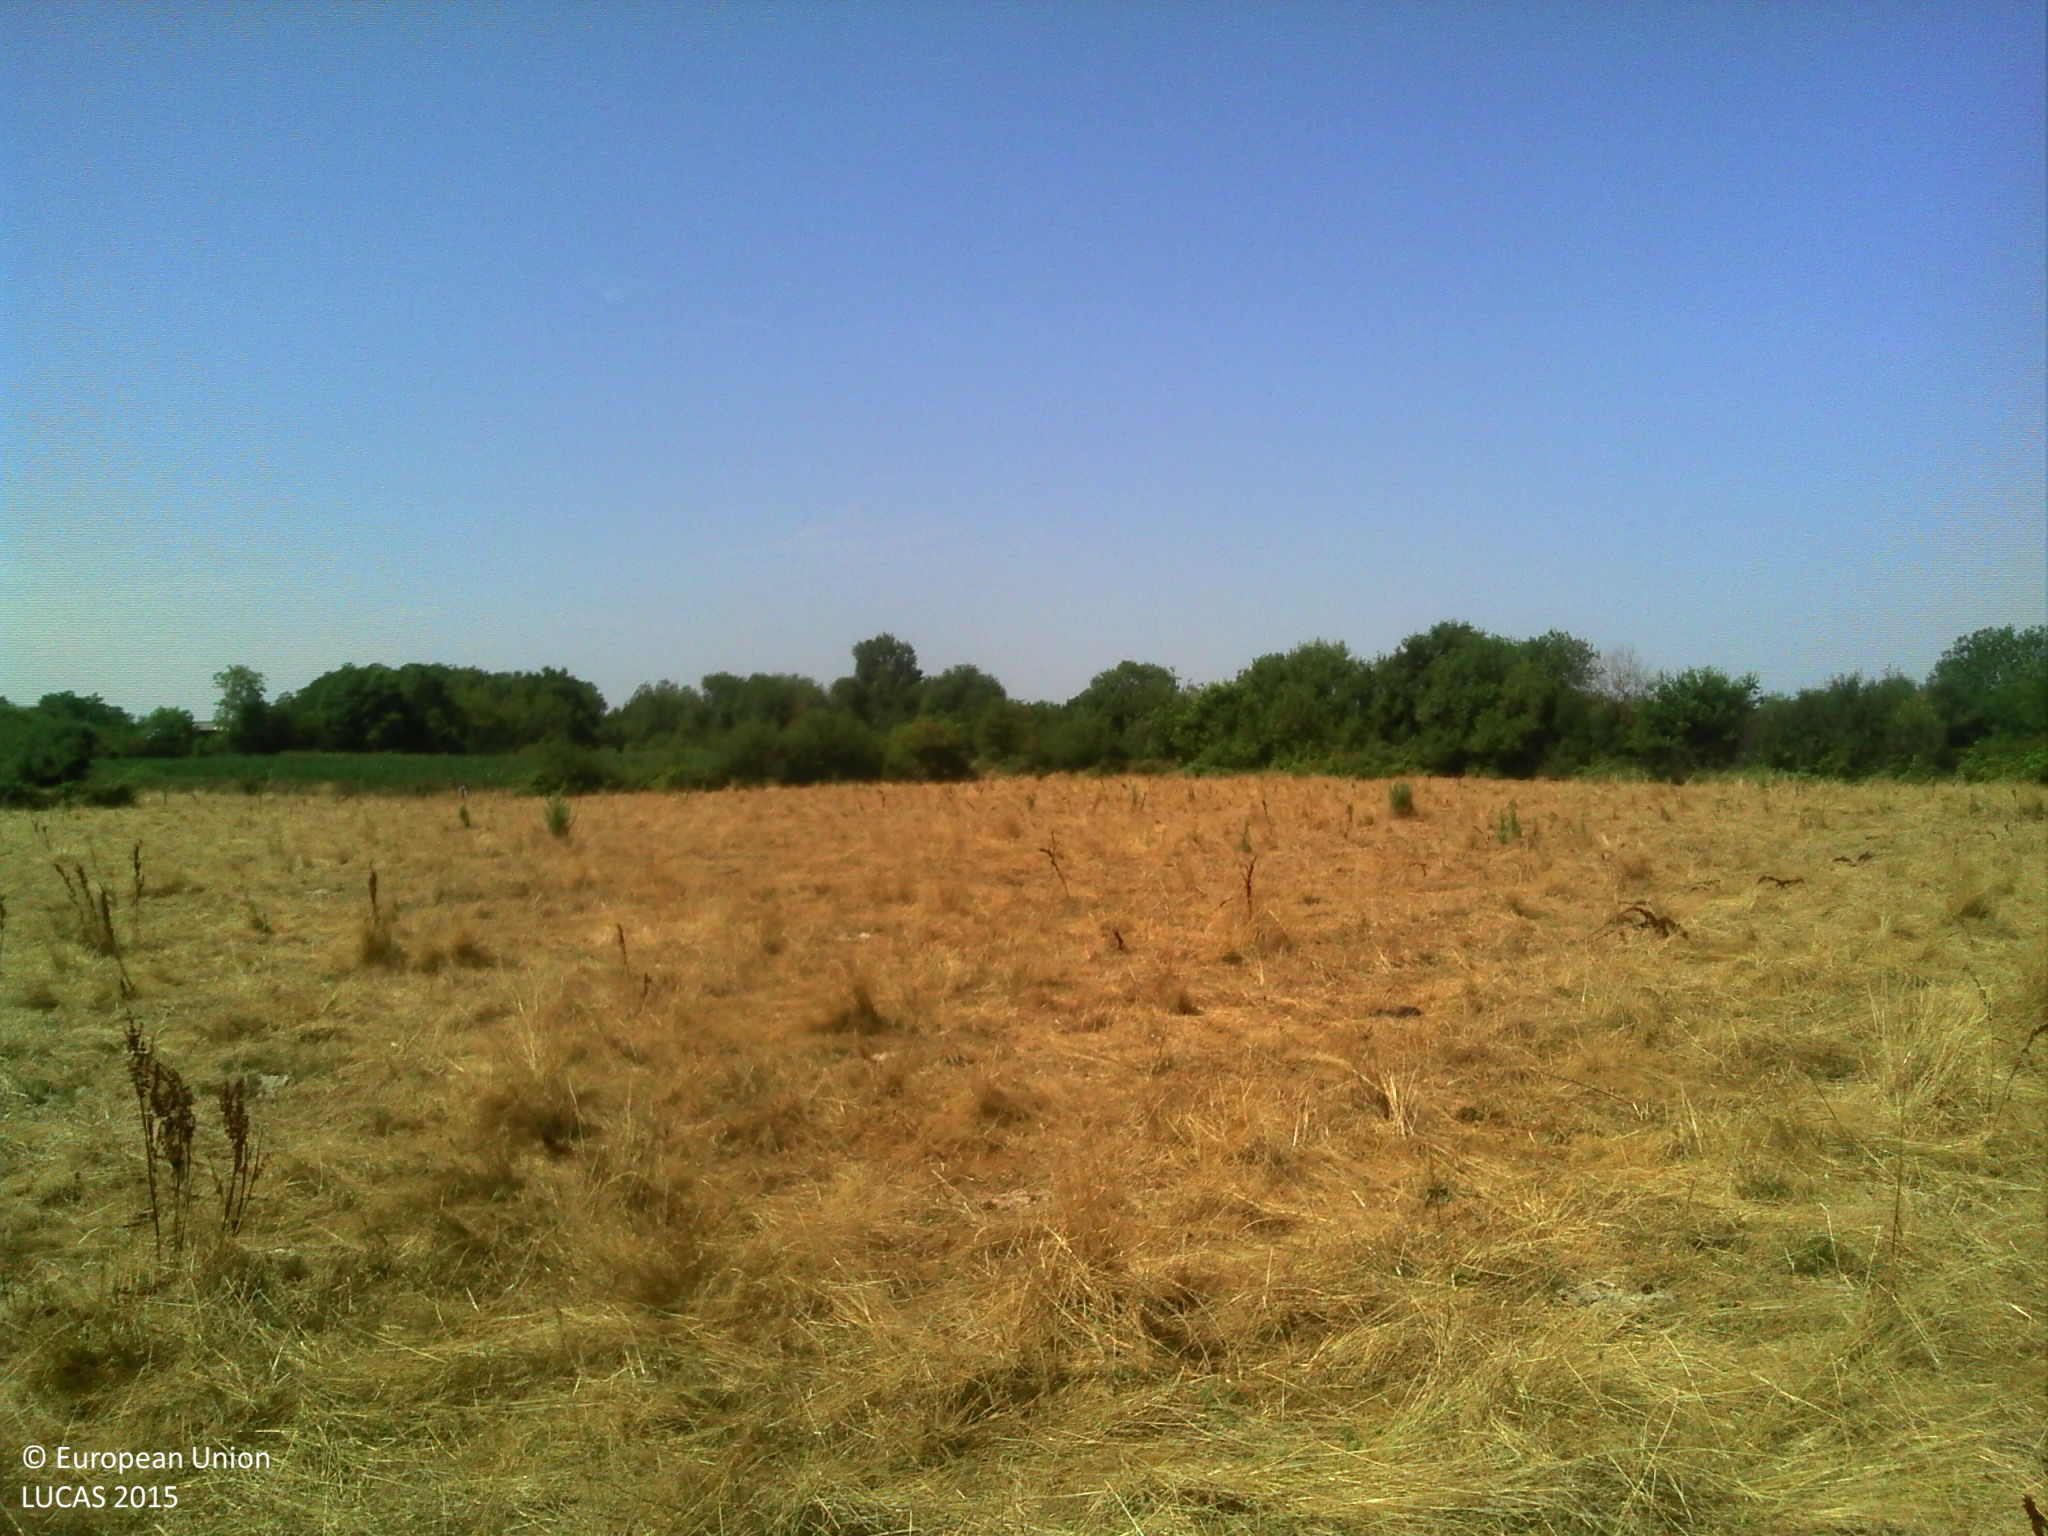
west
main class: Grassland
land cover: Grassland without tree/shrub cover
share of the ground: > 75 %
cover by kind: herbaceous plants 100 %
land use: Agriculture (excluding fallow land and kitchen gardens)
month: July
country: FR
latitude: 46.7582
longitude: 5.0134
